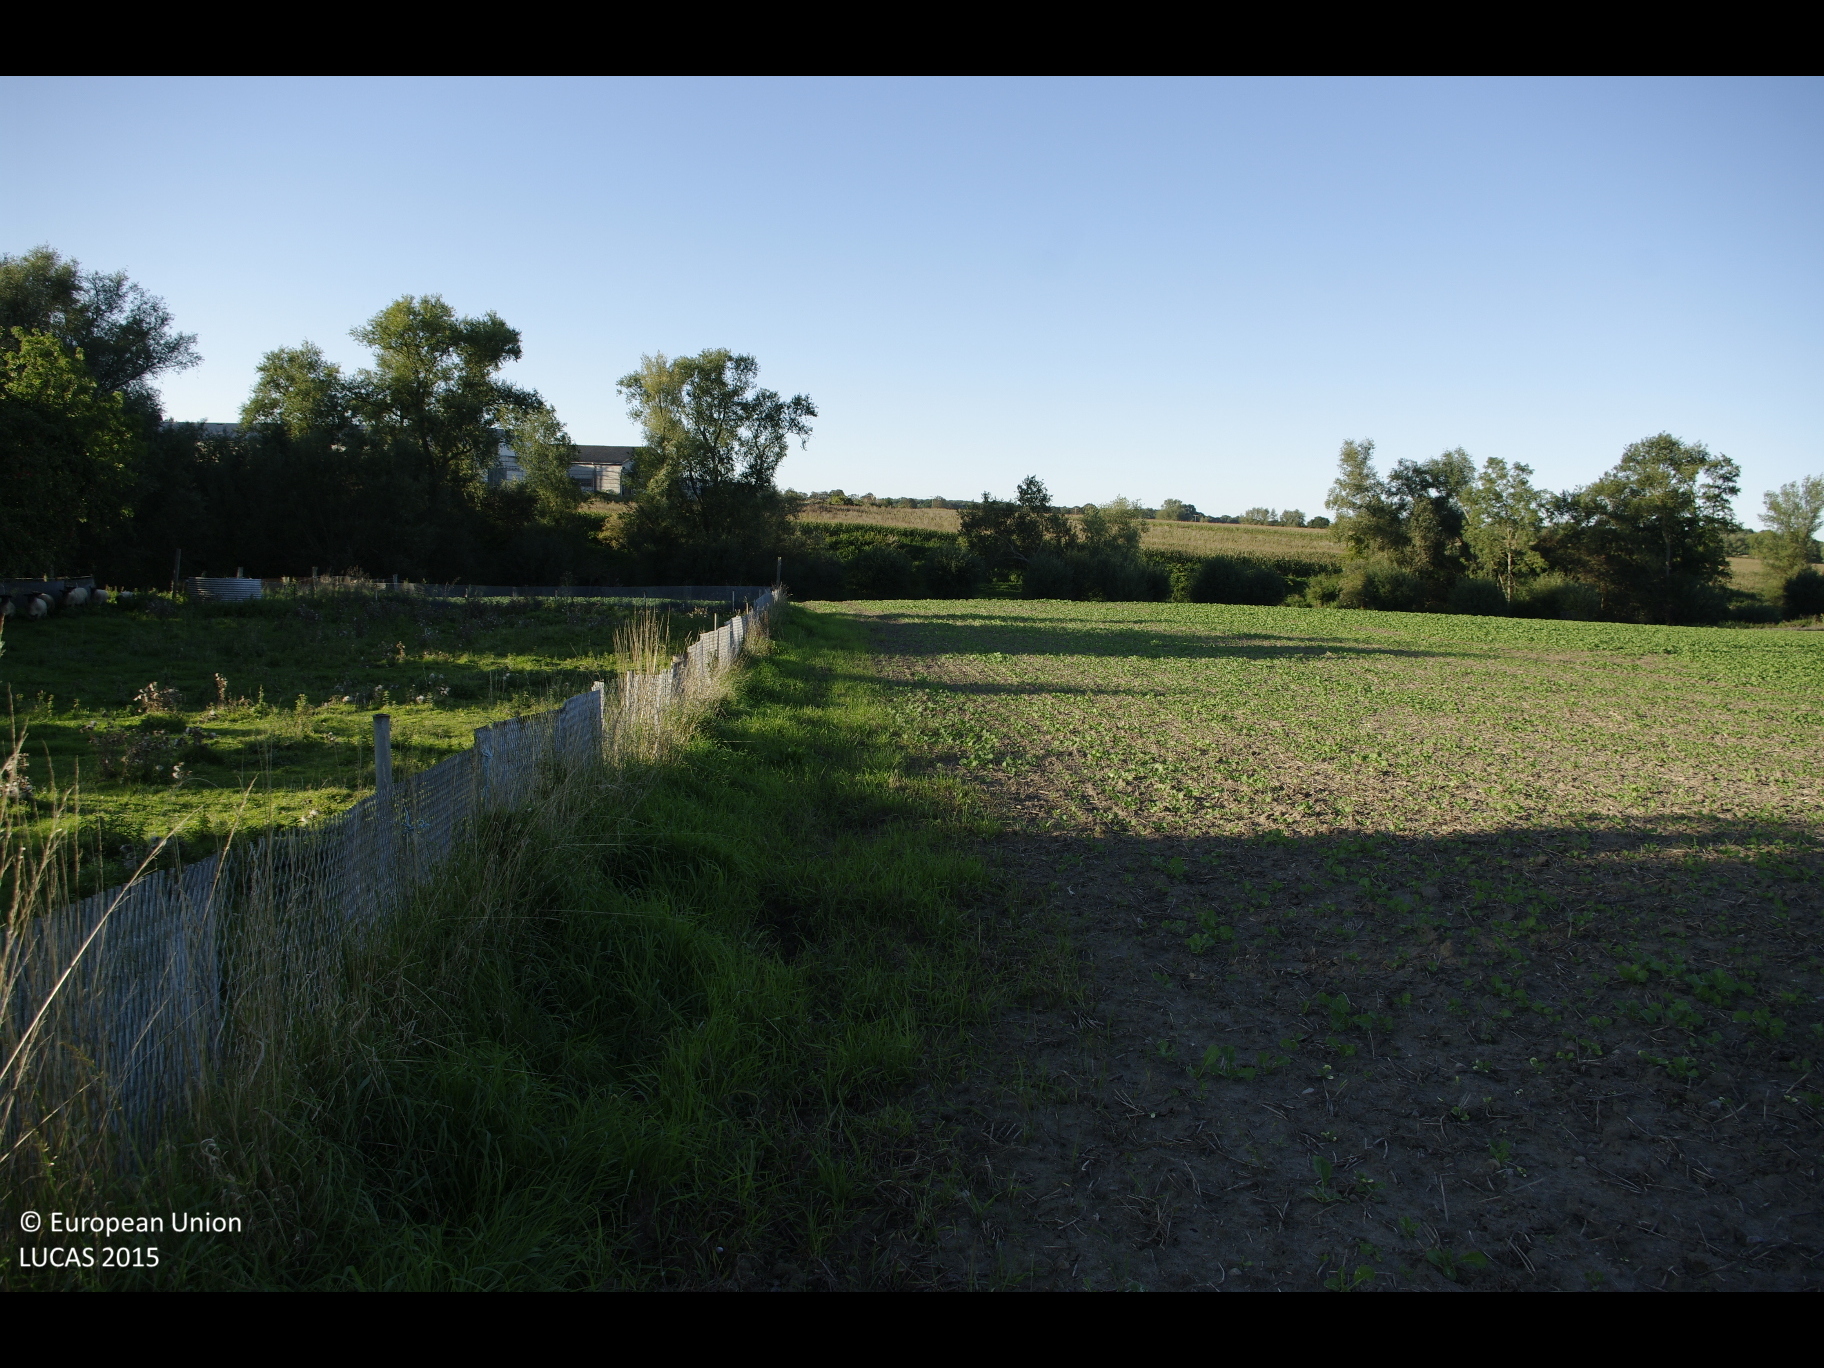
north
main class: Cropland
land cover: Rape and turnip rape
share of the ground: 50 - 75 %
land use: Agriculture (excluding fallow land and kitchen gardens)
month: September
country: DE
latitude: 53.9191
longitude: 10.9892
